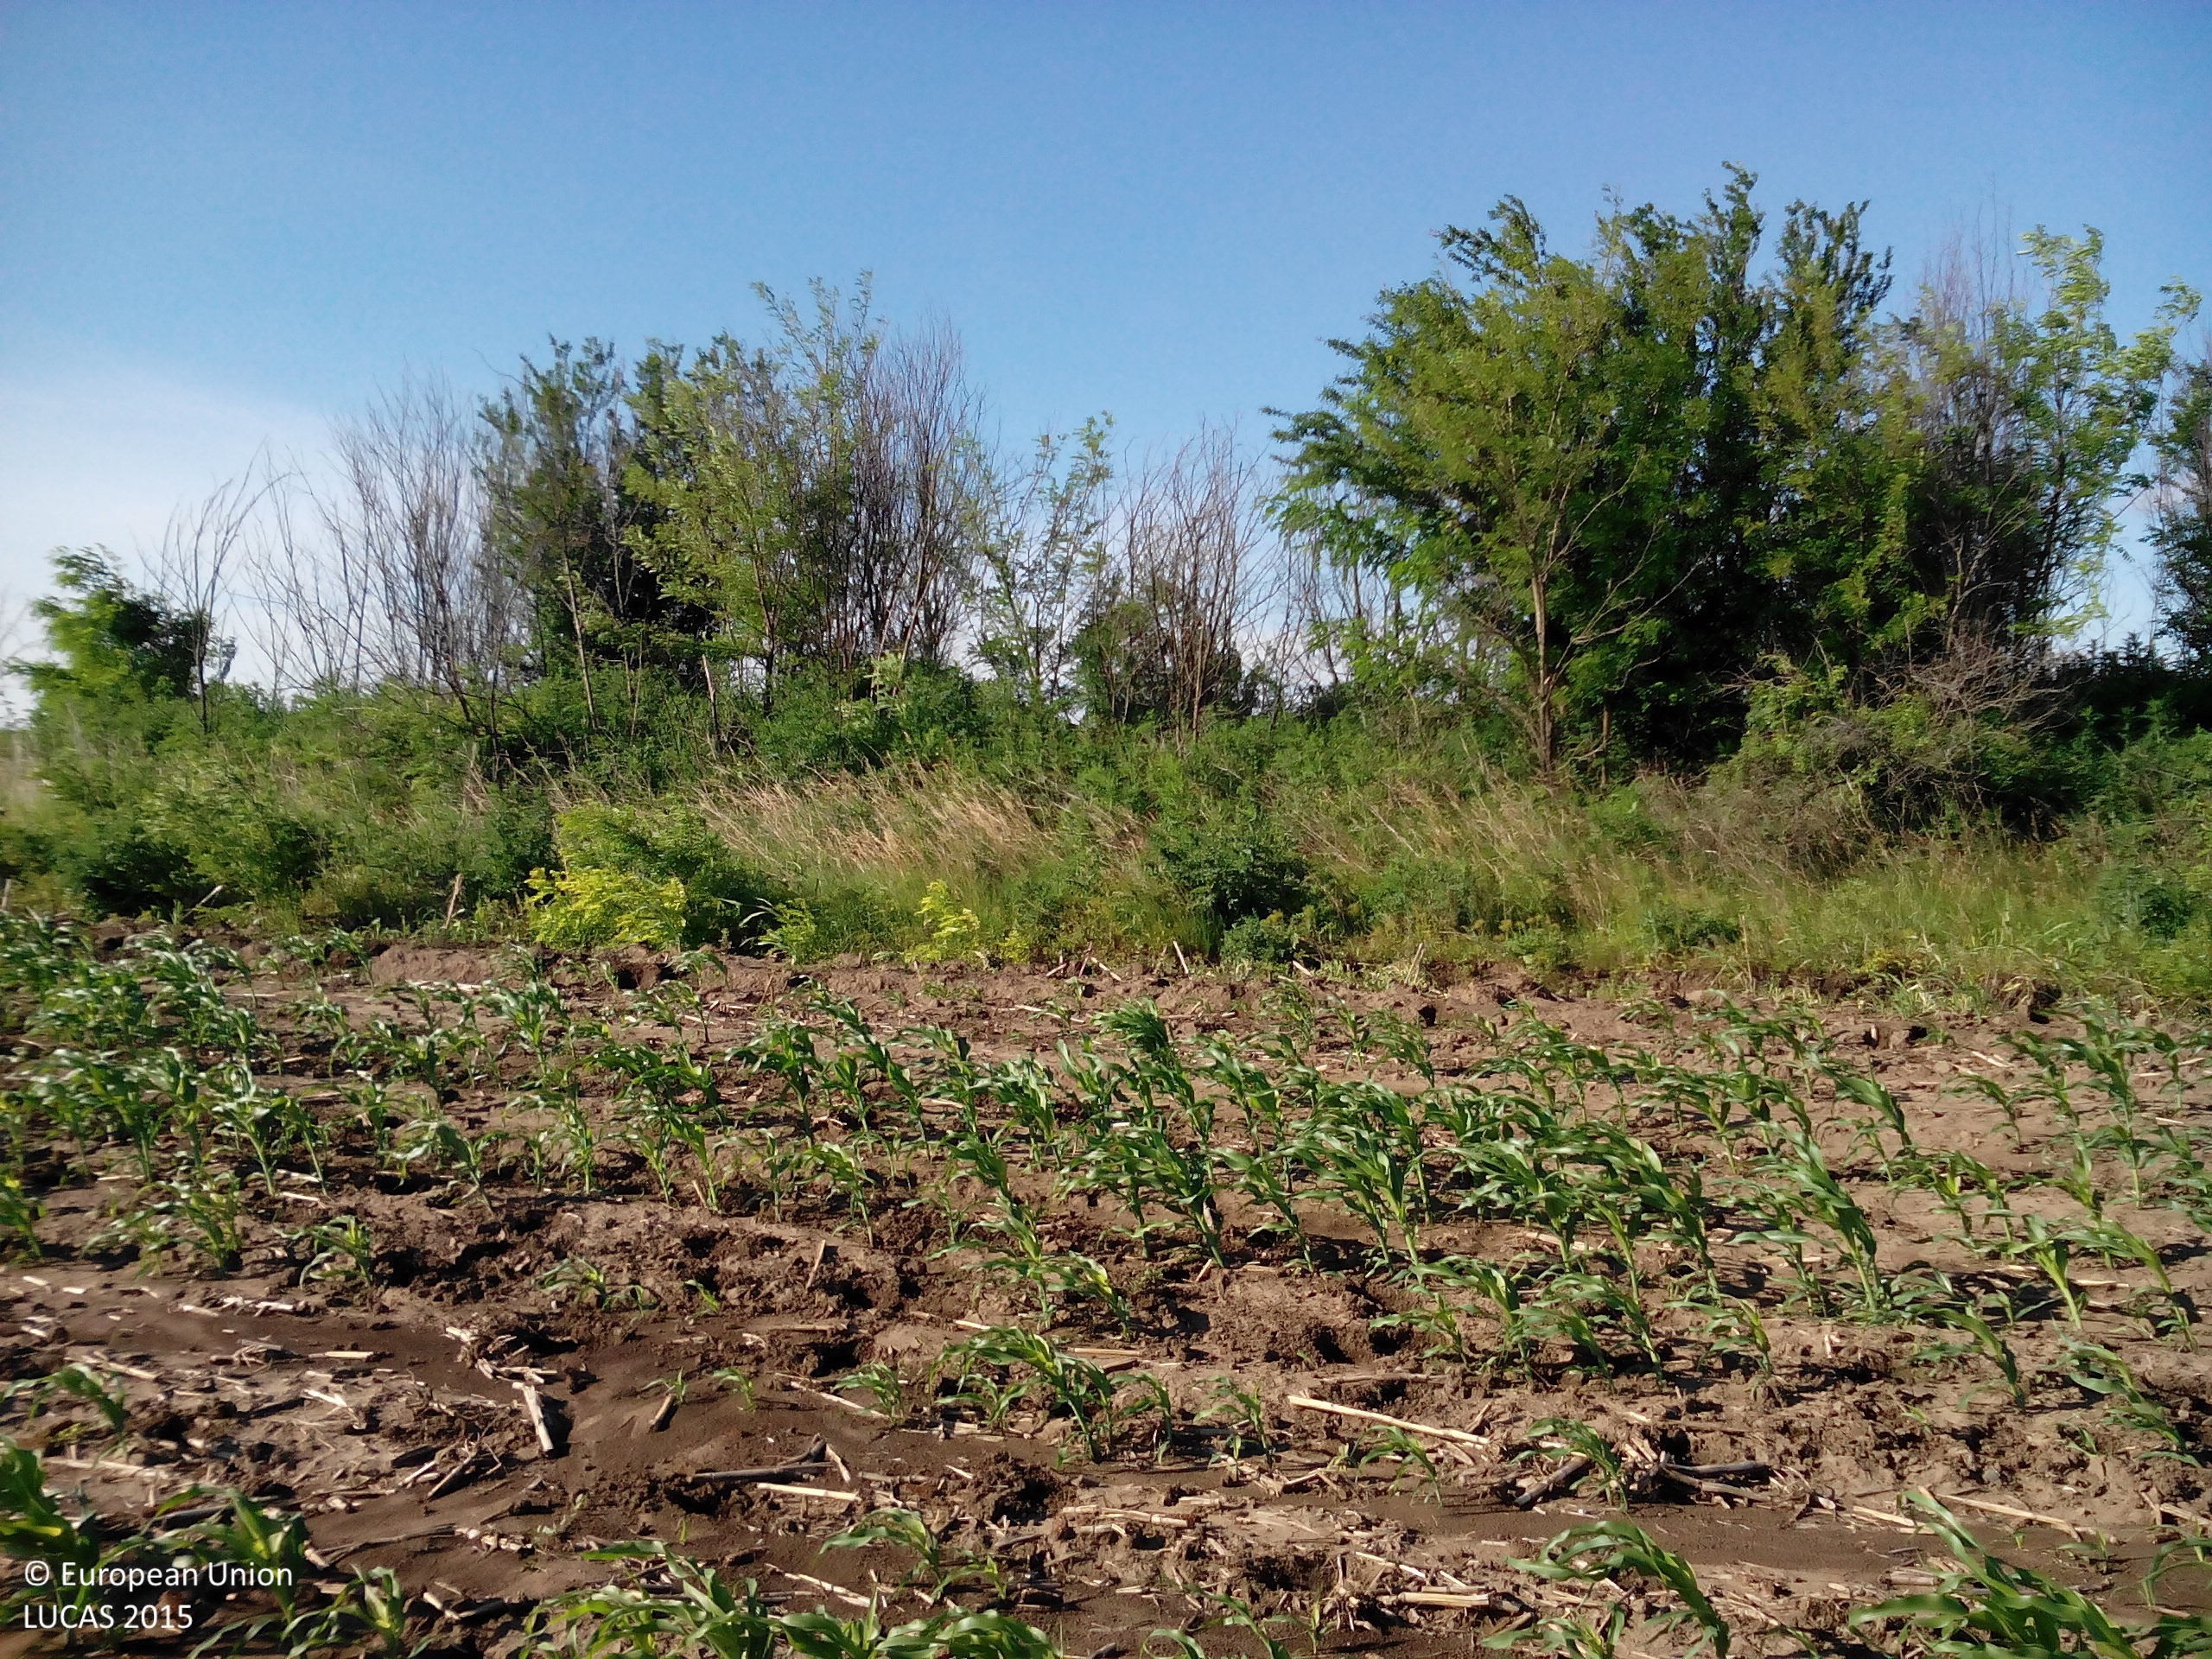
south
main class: Cropland
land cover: Maize
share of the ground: 25 - 50 %
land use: Agriculture (excluding fallow land and kitchen gardens)
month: May
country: BG
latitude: 43.5422
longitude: 24.0011
